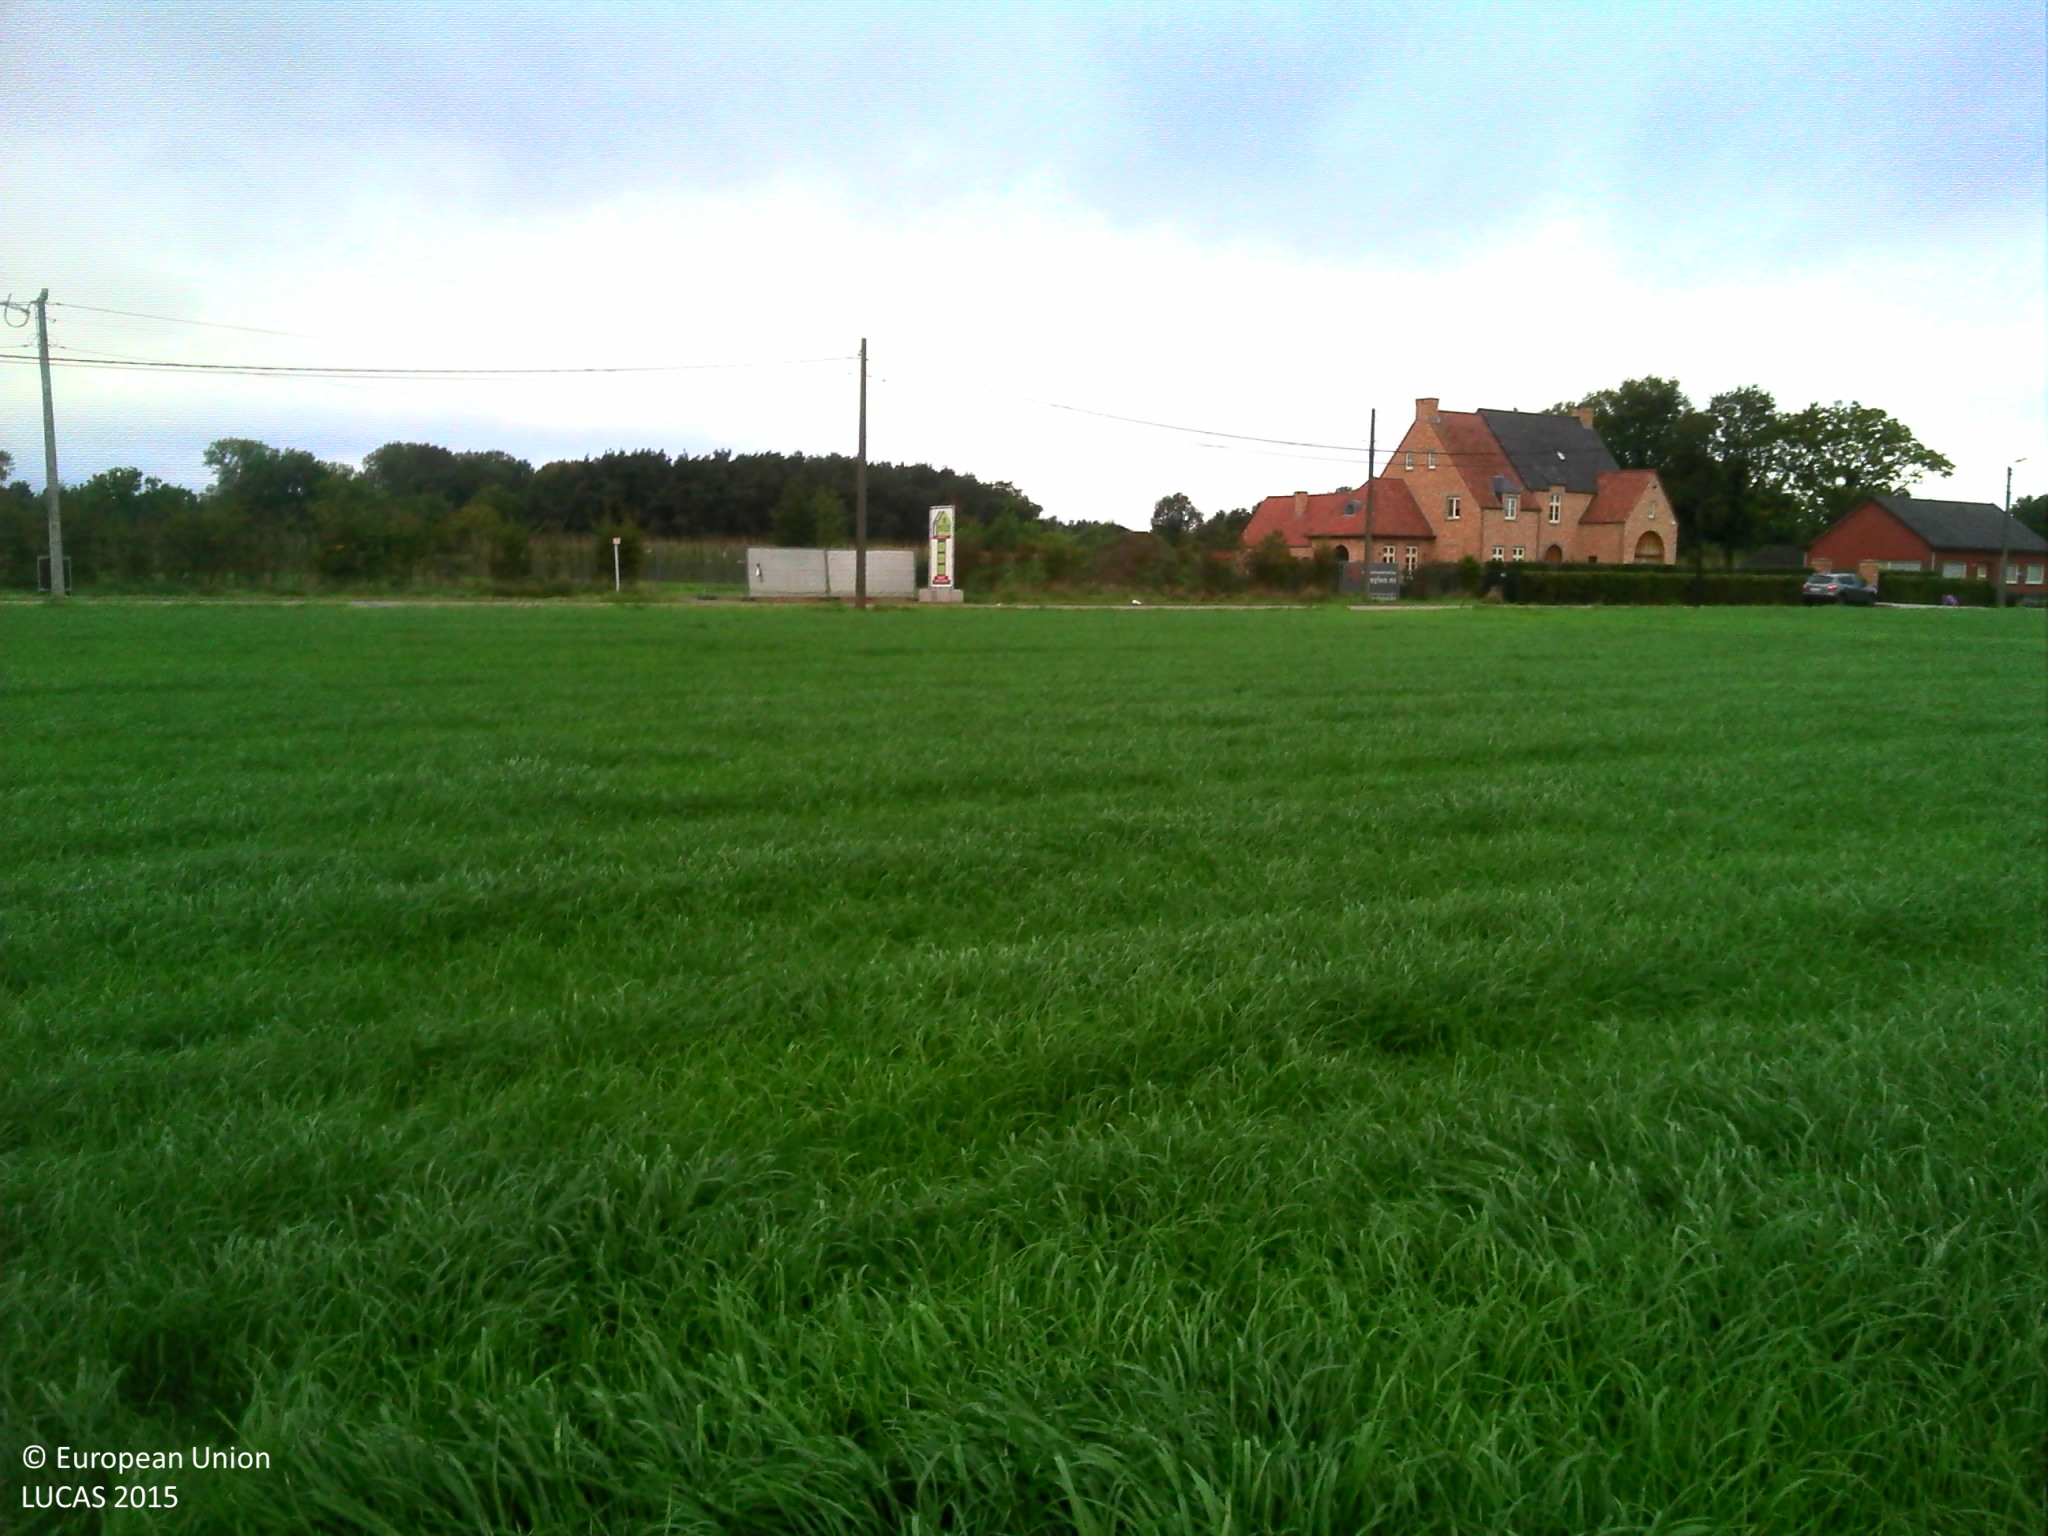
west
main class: Cropland
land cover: Temporary grasslands
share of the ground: > 75 %
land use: Agriculture (excluding fallow land and kitchen gardens)
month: October
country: BE
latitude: 51.0382
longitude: 4.7911
